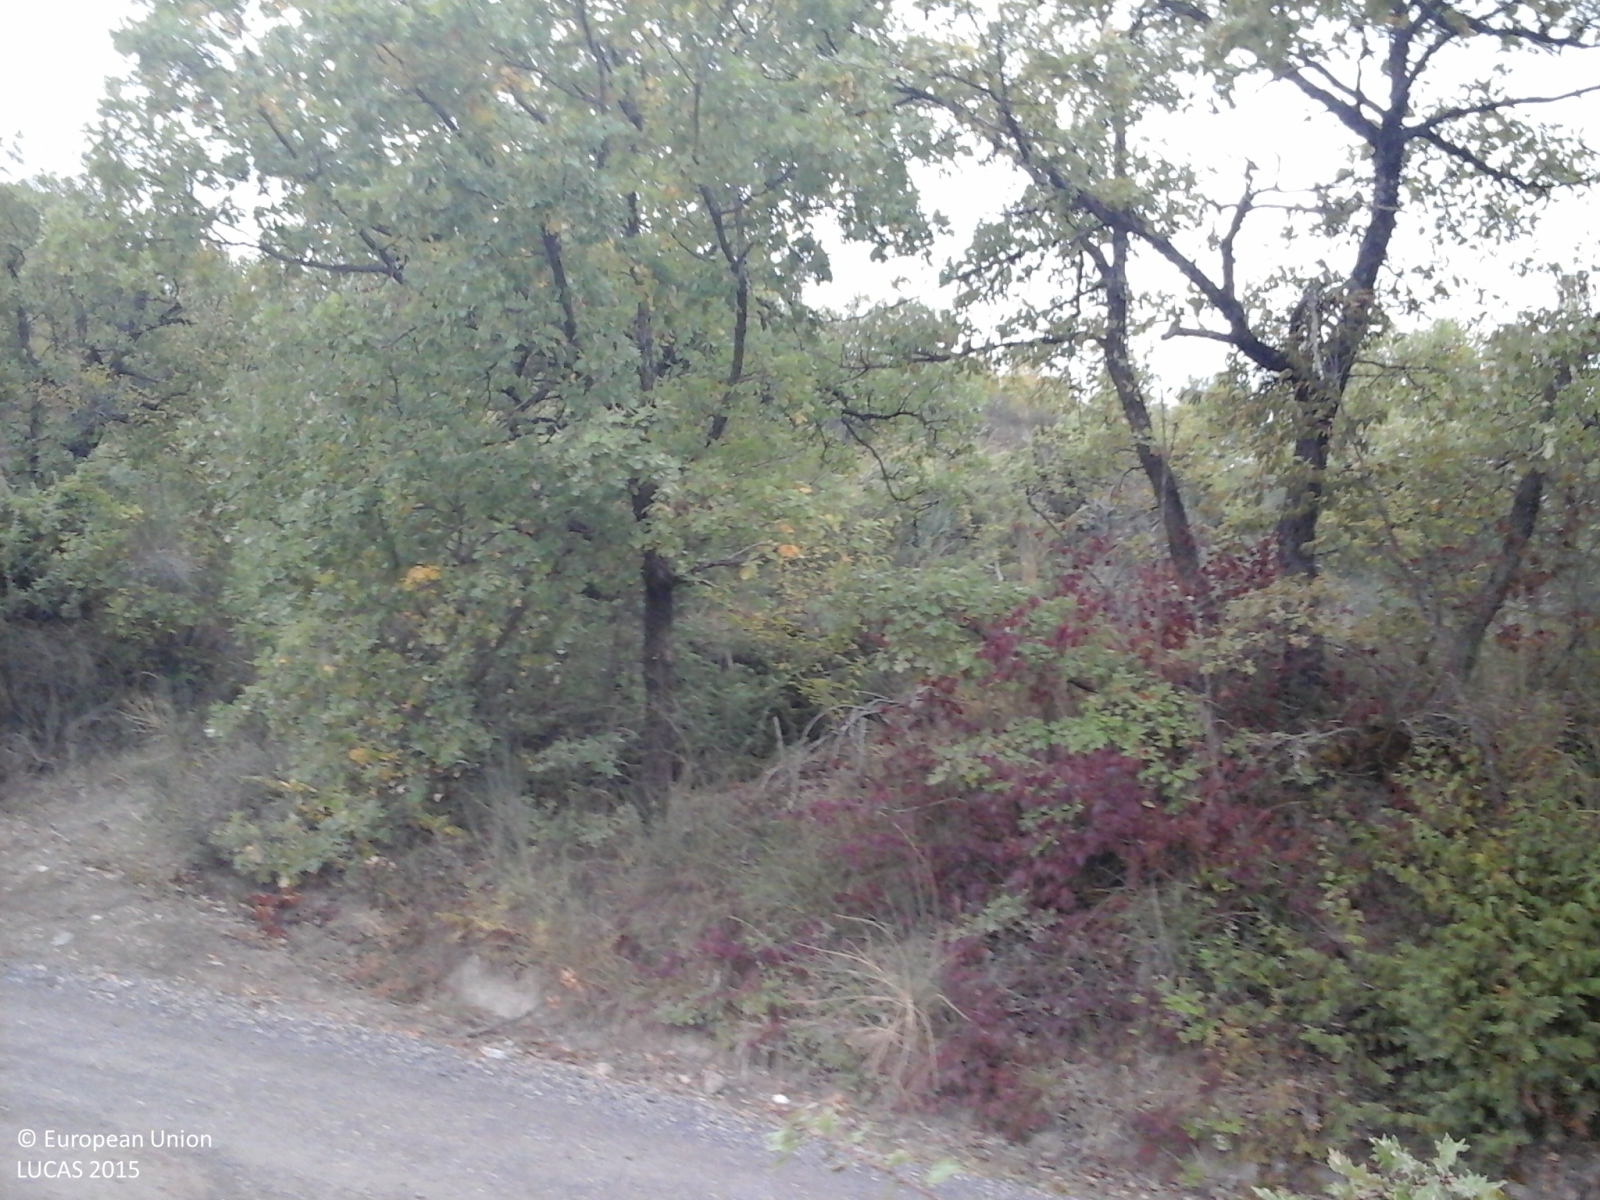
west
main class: Shrubland
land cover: Shrubland with sparse tree cover
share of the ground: > 75 %
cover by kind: shrubs 60 %, herbaceous plants 35 %, broadleaved forest trees 5 %
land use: Agriculture (excluding fallow land and kitchen gardens)
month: October
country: IT
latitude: 43.2235
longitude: 12.3203
